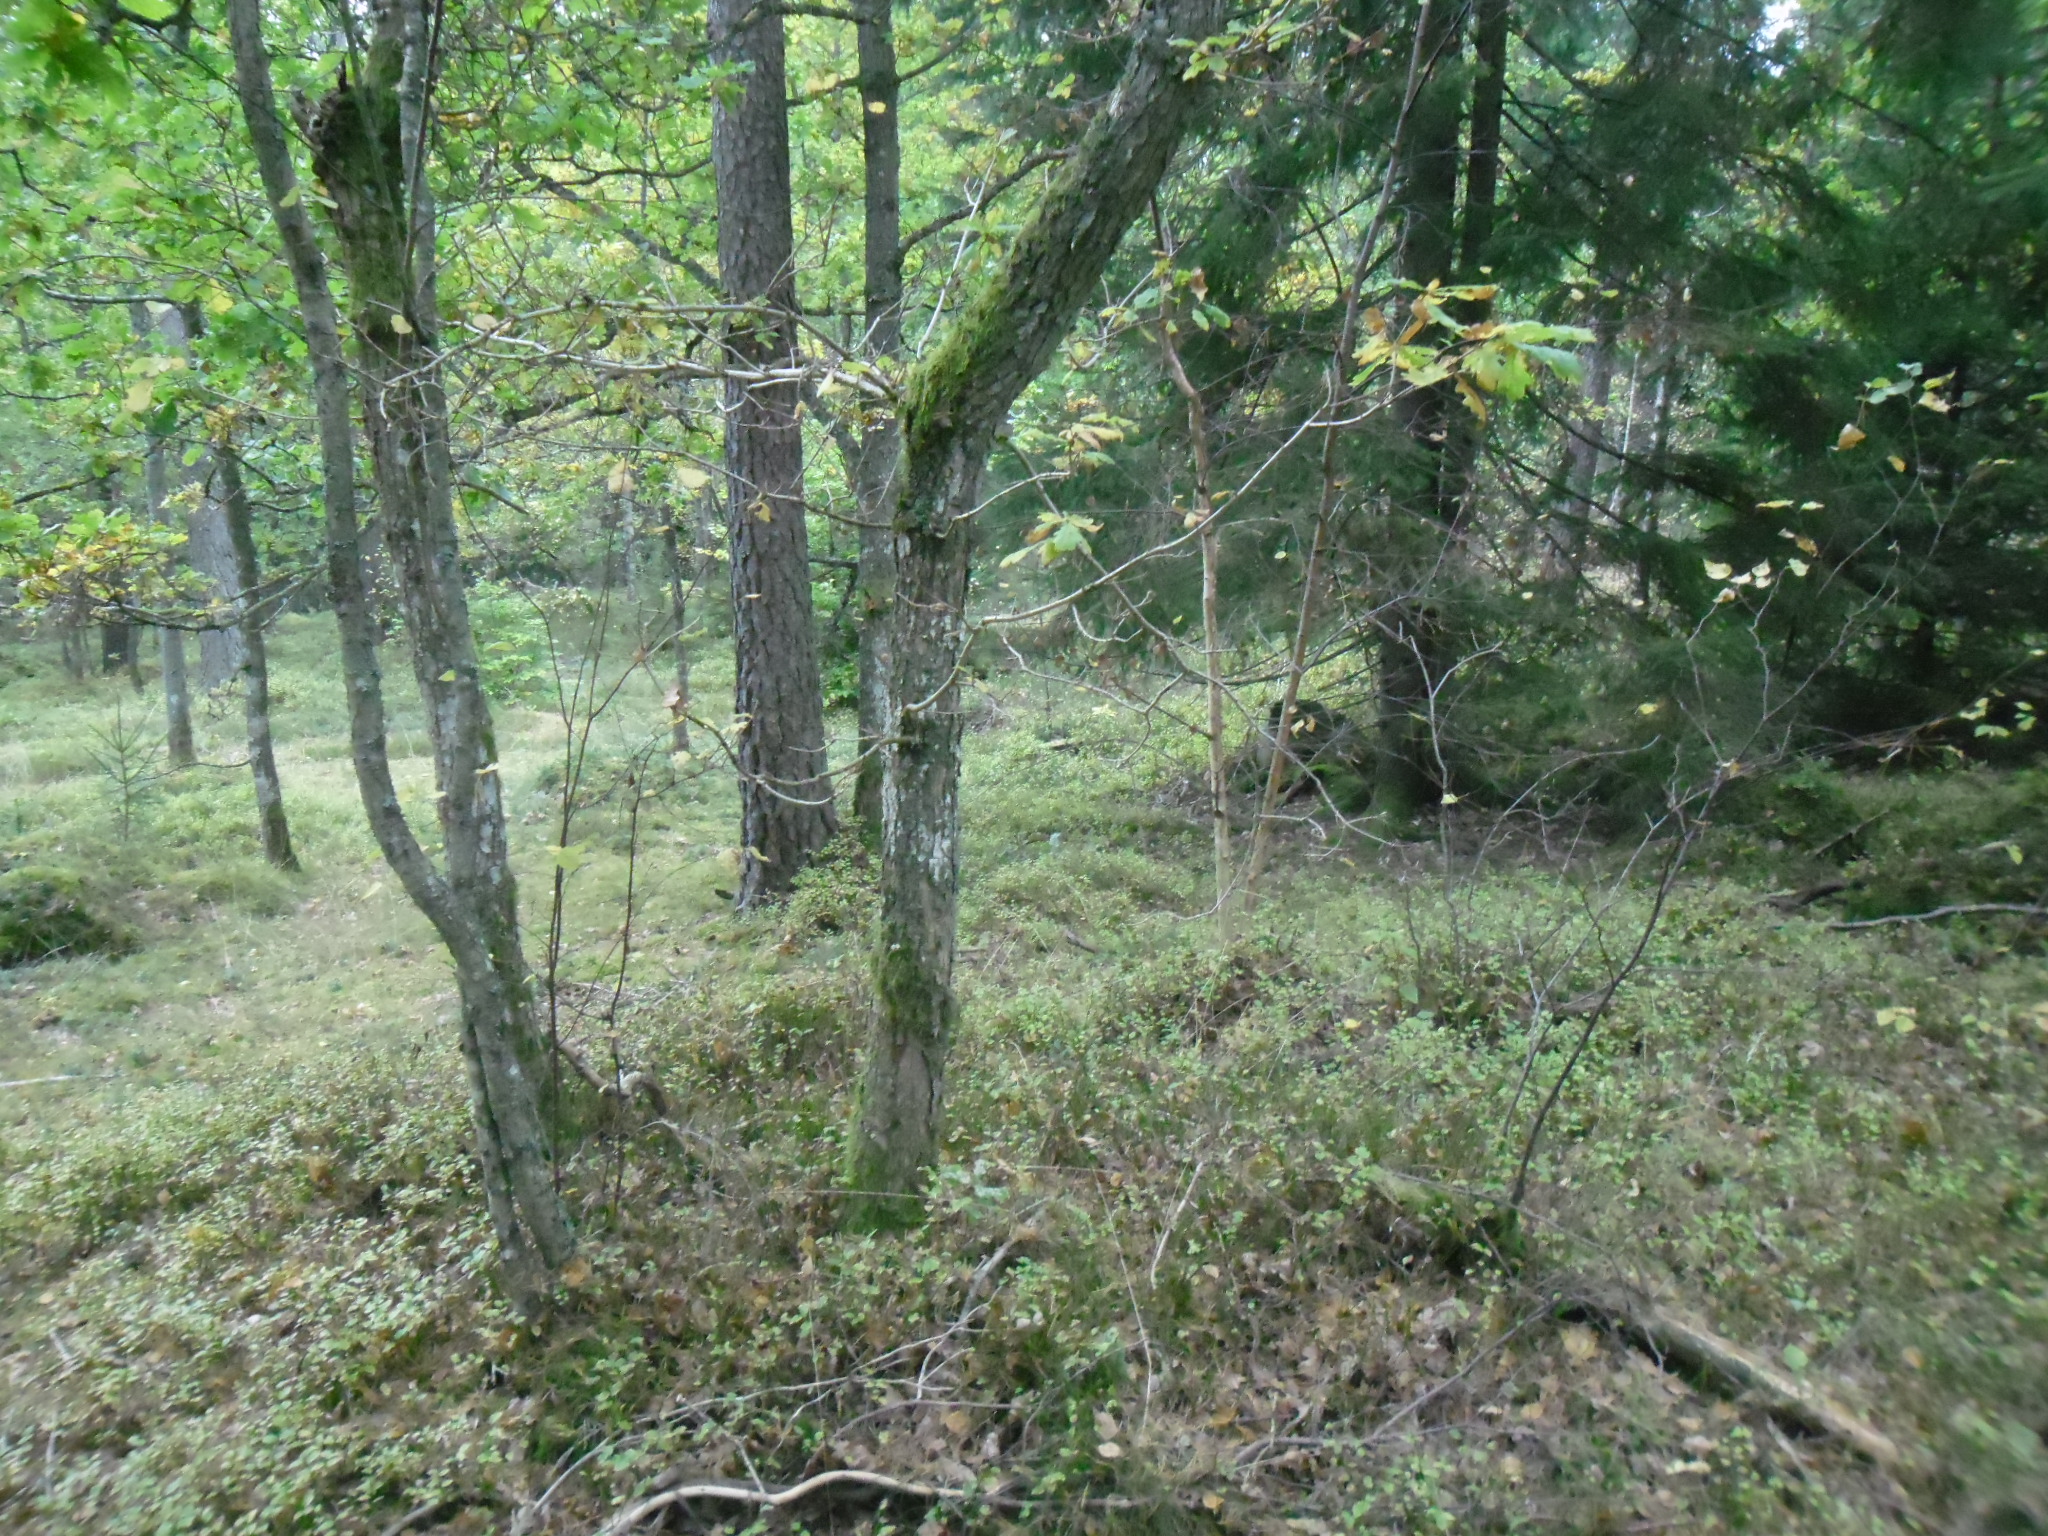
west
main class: Woodland
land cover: Spruce dominated mixed woodland
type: hemiboreal forest and nemoral coniferous forest and mixed broadleaved-coniferous forest
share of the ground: 50 - 75 %
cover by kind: coniferous forest trees 45 %, shrubs 30 %, broadleaved forest trees 15 %, herbaceous plants 10 %
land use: Forestry
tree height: > 5 m
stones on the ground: 25 - 50 %
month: October
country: SE
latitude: 56.3655
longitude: 13.8014
